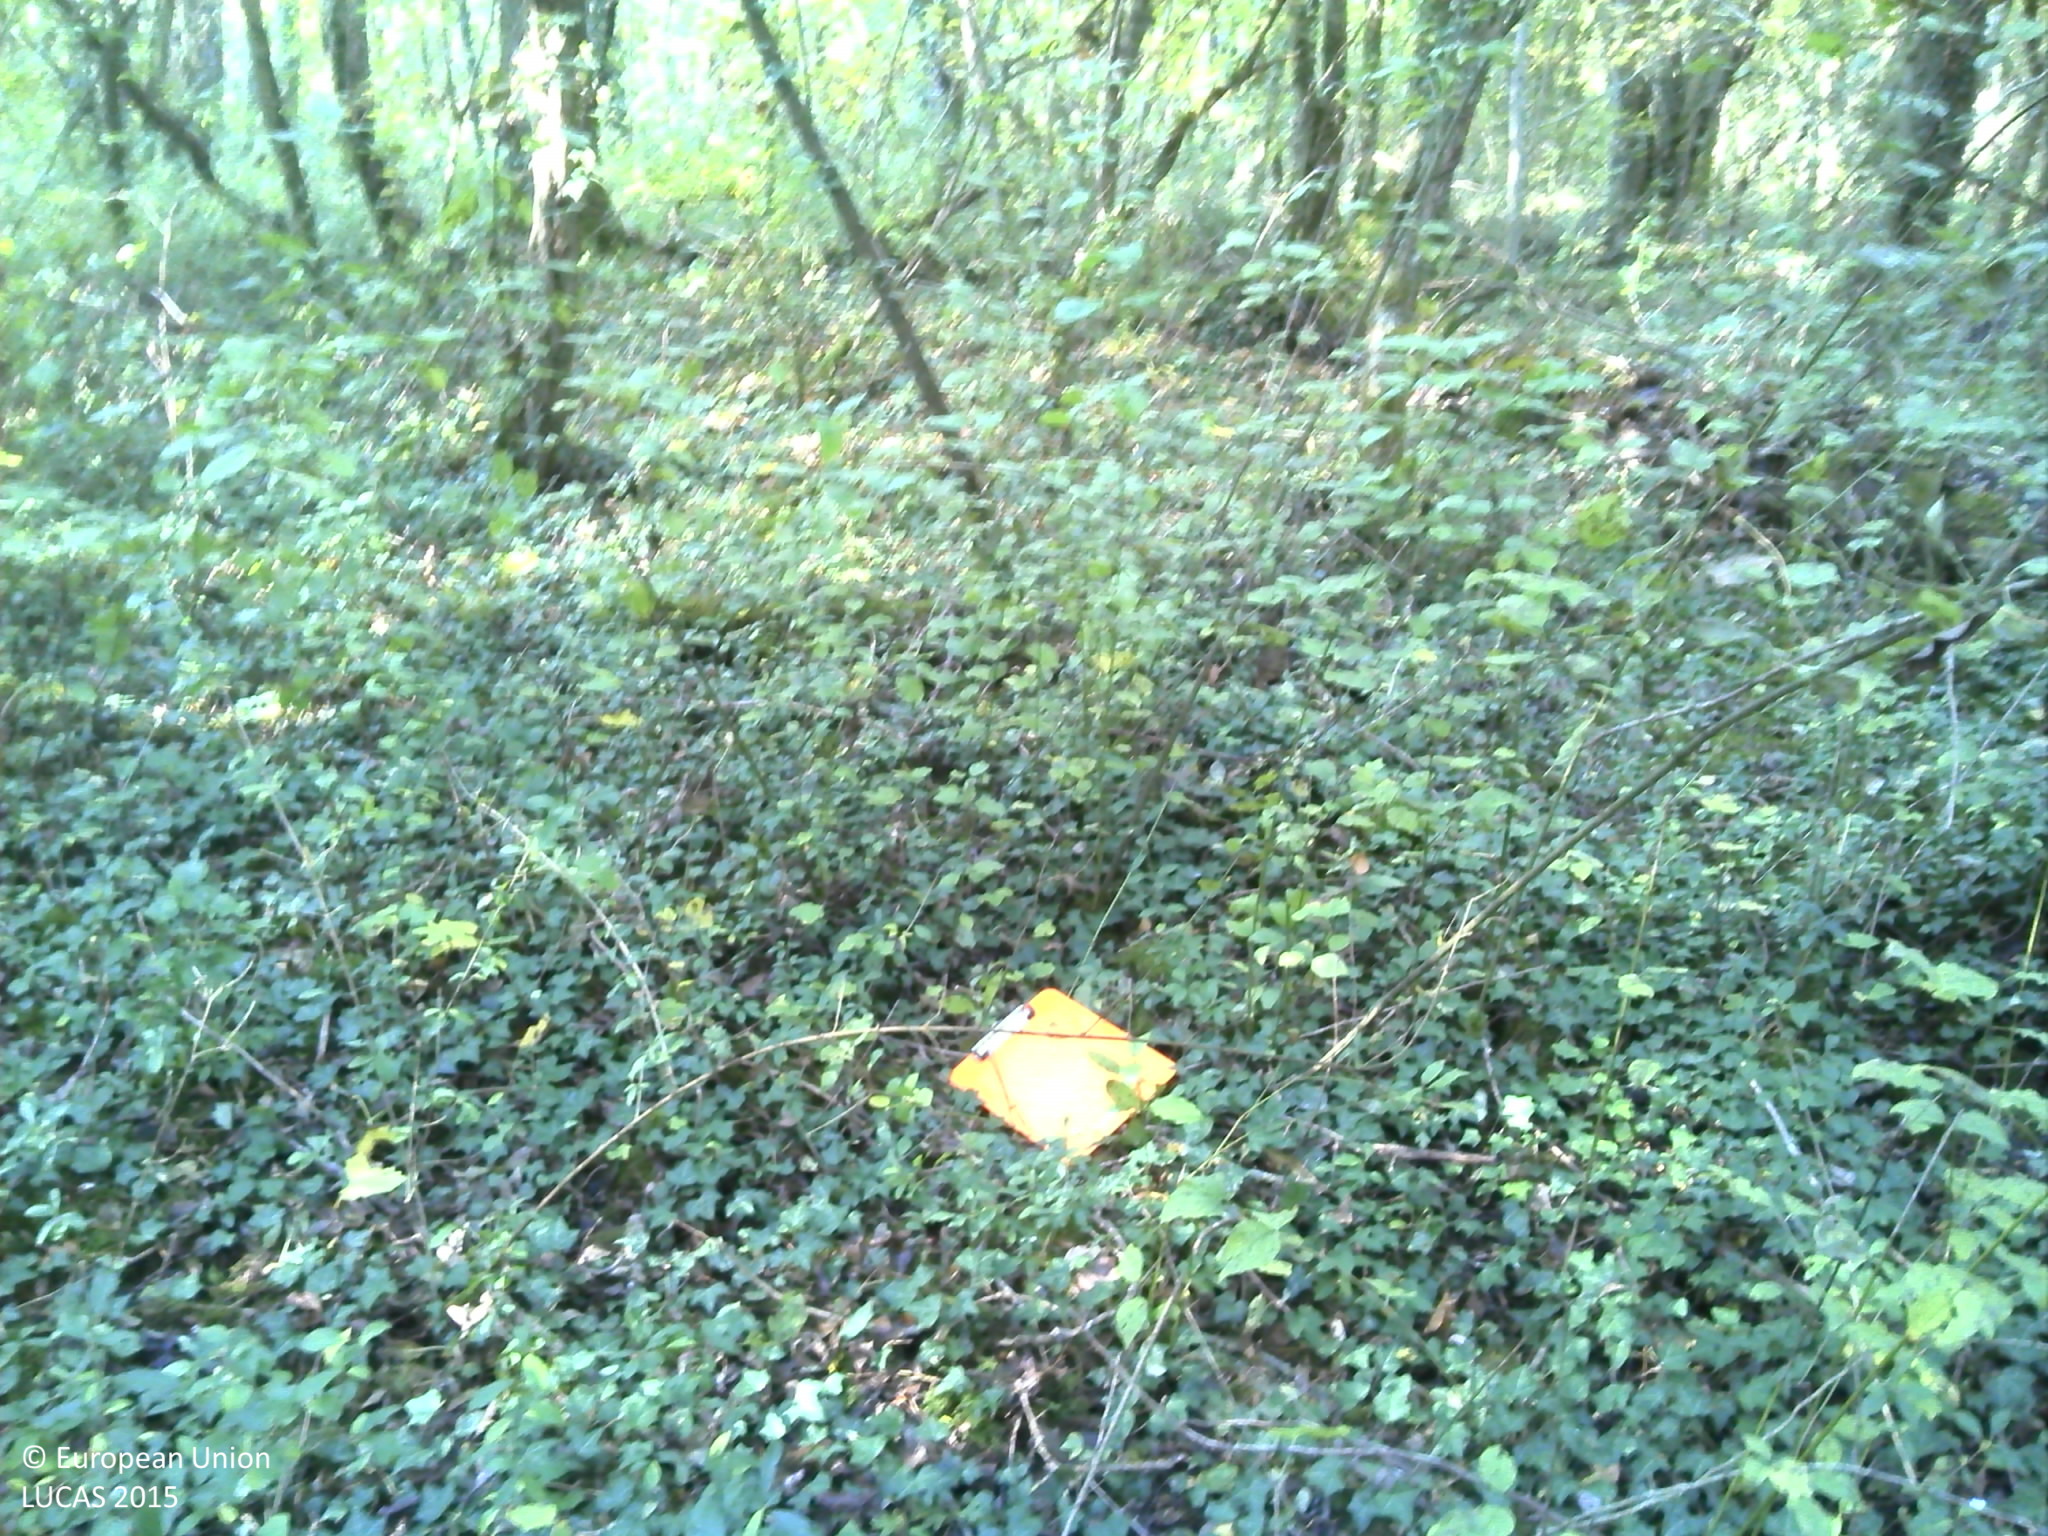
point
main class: Woodland
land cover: Broadleaved woodland
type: mesophytic deciduous forest
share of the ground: > 75 %
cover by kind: broadleaved forest trees 100 %
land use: Forestry
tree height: > 5 m
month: October
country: FR
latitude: 47.1854
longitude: 5.2899
